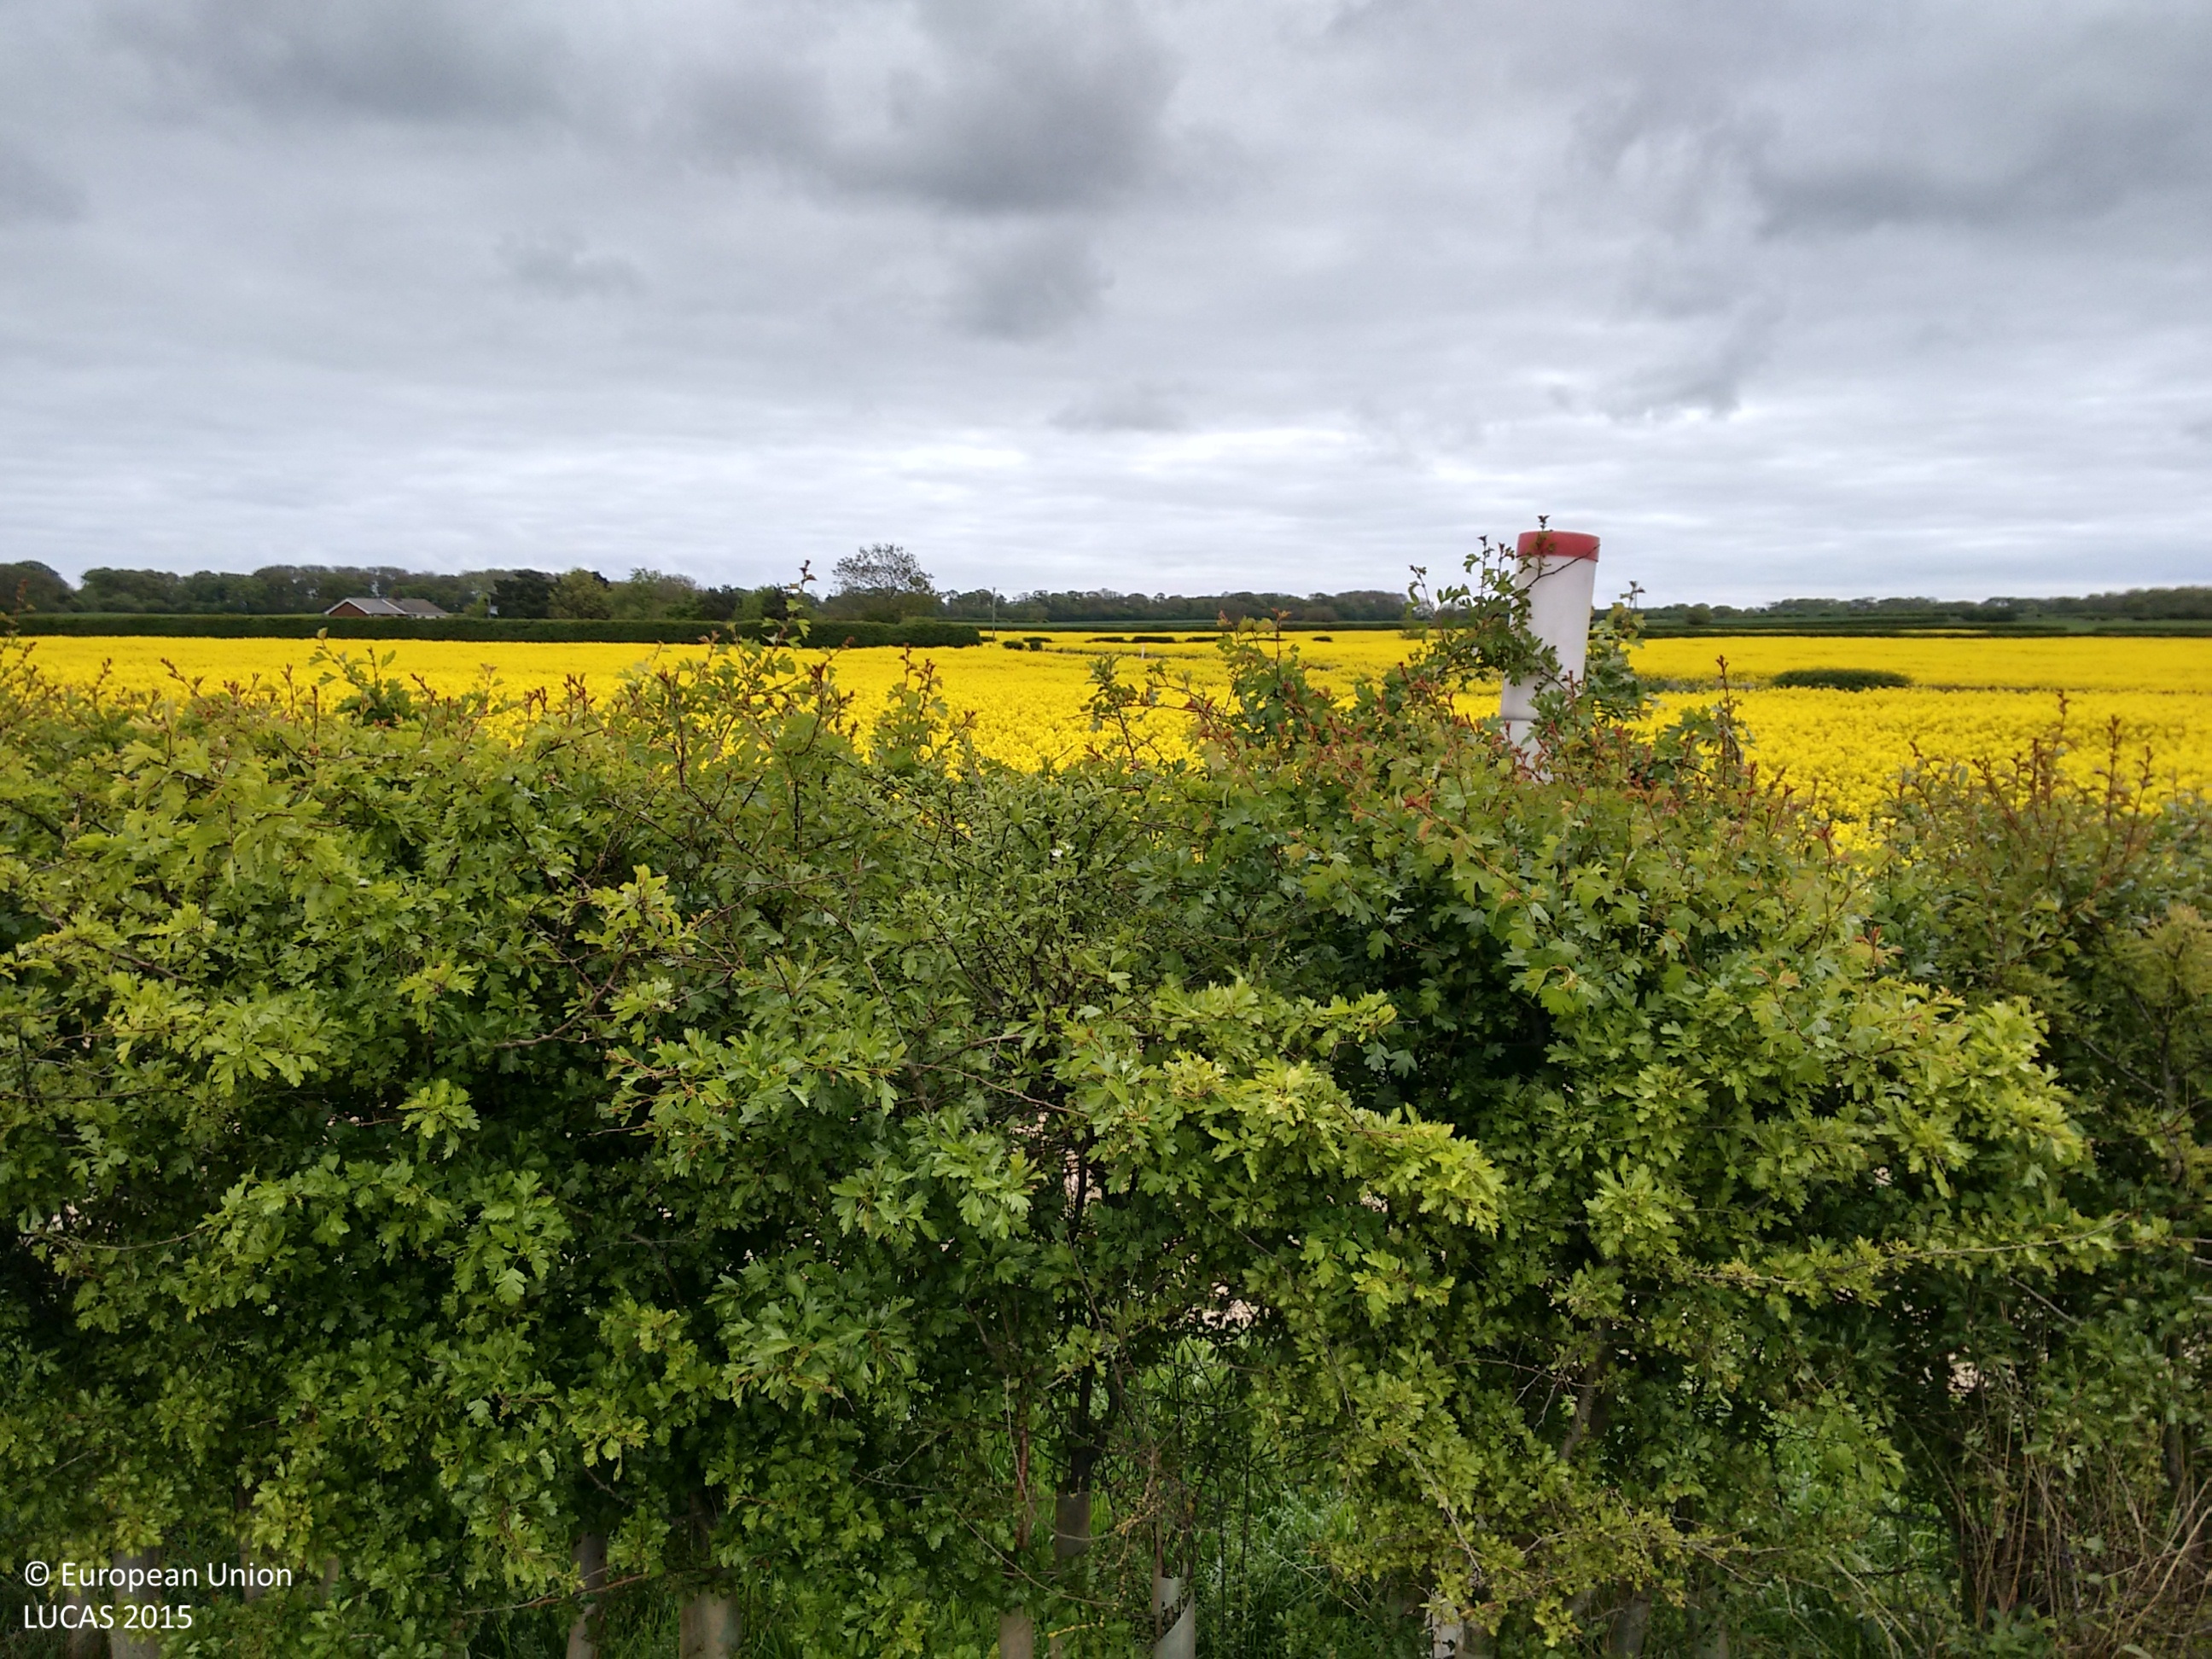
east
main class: Cropland
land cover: Dry pulses
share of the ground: 25 - 50 %
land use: Agriculture (excluding fallow land and kitchen gardens)
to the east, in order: Dry pulses; Grass margins; Managed hedges; Grass margins; Rape and turnip rape; Grass margins; Paved roads, cycling and walking lanes
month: May
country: GB
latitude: 53.8021
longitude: -0.2219
